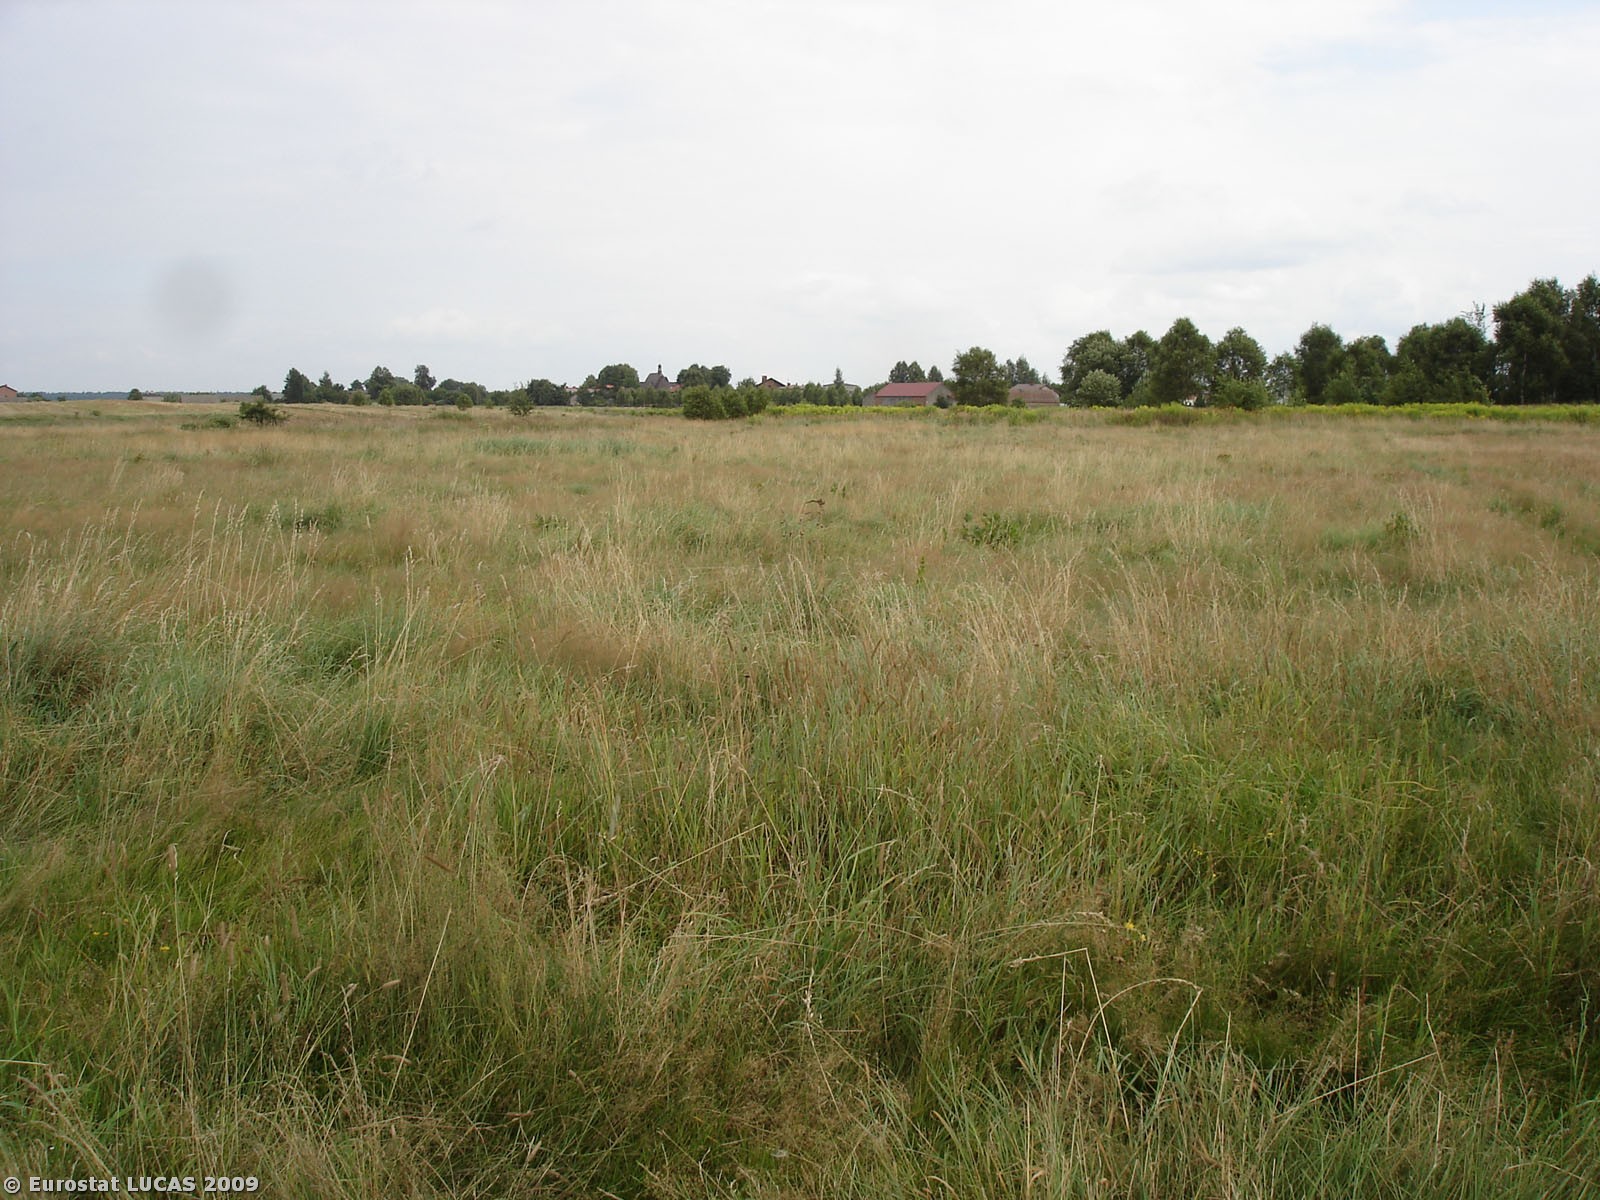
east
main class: Grassland
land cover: Grassland without tree/shrub cover
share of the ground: > 75 %
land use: Agriculture (excluding fallow land and kitchen gardens)
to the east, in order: Grassland without tree/shrub cover; Shruby margins; Ditches and canals; Grass margins; Grassland without tree/shrub cover; Spontaneously vegetated surfaces
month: August
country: PL
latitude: 50.8175
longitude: 18.8364
